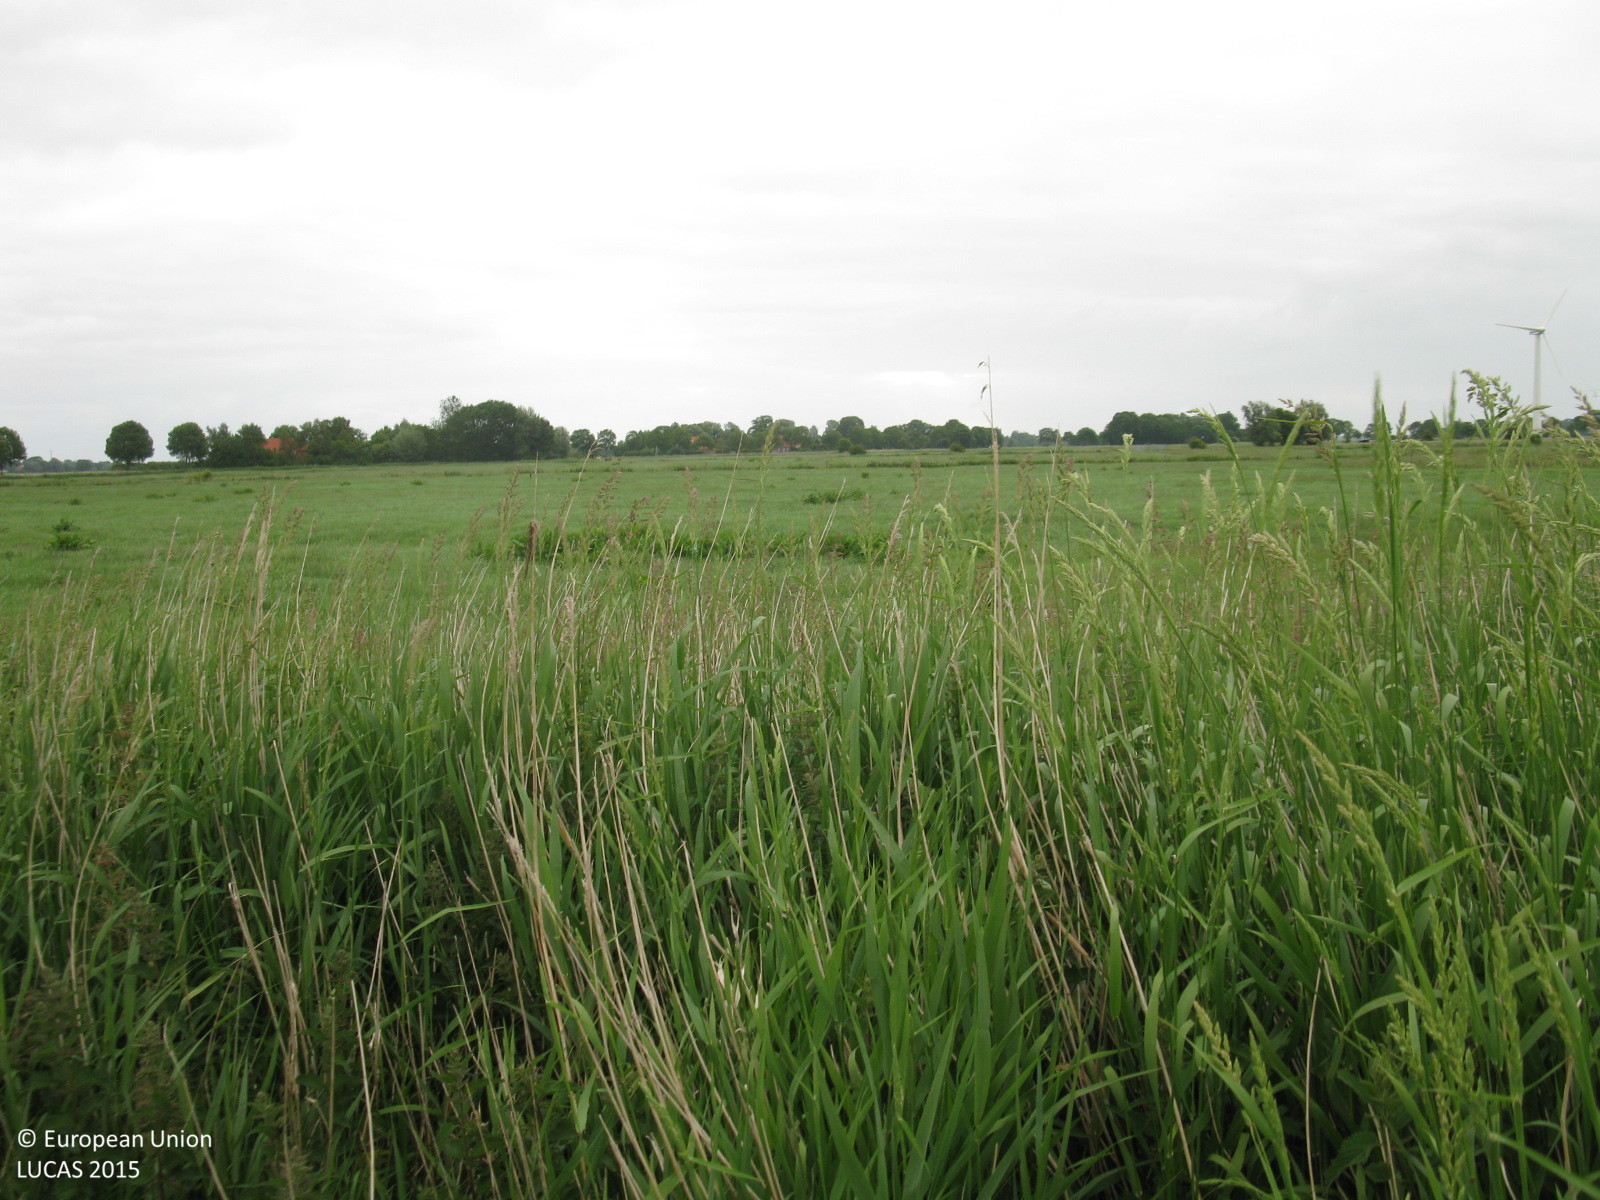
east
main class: Grassland
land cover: Grassland without tree/shrub cover
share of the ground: > 75 %
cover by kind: herbaceous plants 100 %
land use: Agriculture (excluding fallow land and kitchen gardens)
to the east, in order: Grassland without tree/shrub cover; Fences; Grass margins; Ditches and canals; Grass margins; Fences; Grassland without tree/shrub cover; Fences; Grass margins; Ditches and canals; Grass margins; Fences; Grassland without tree/shrub cover
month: June
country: DE
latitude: 53.6005
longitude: 7.9607
